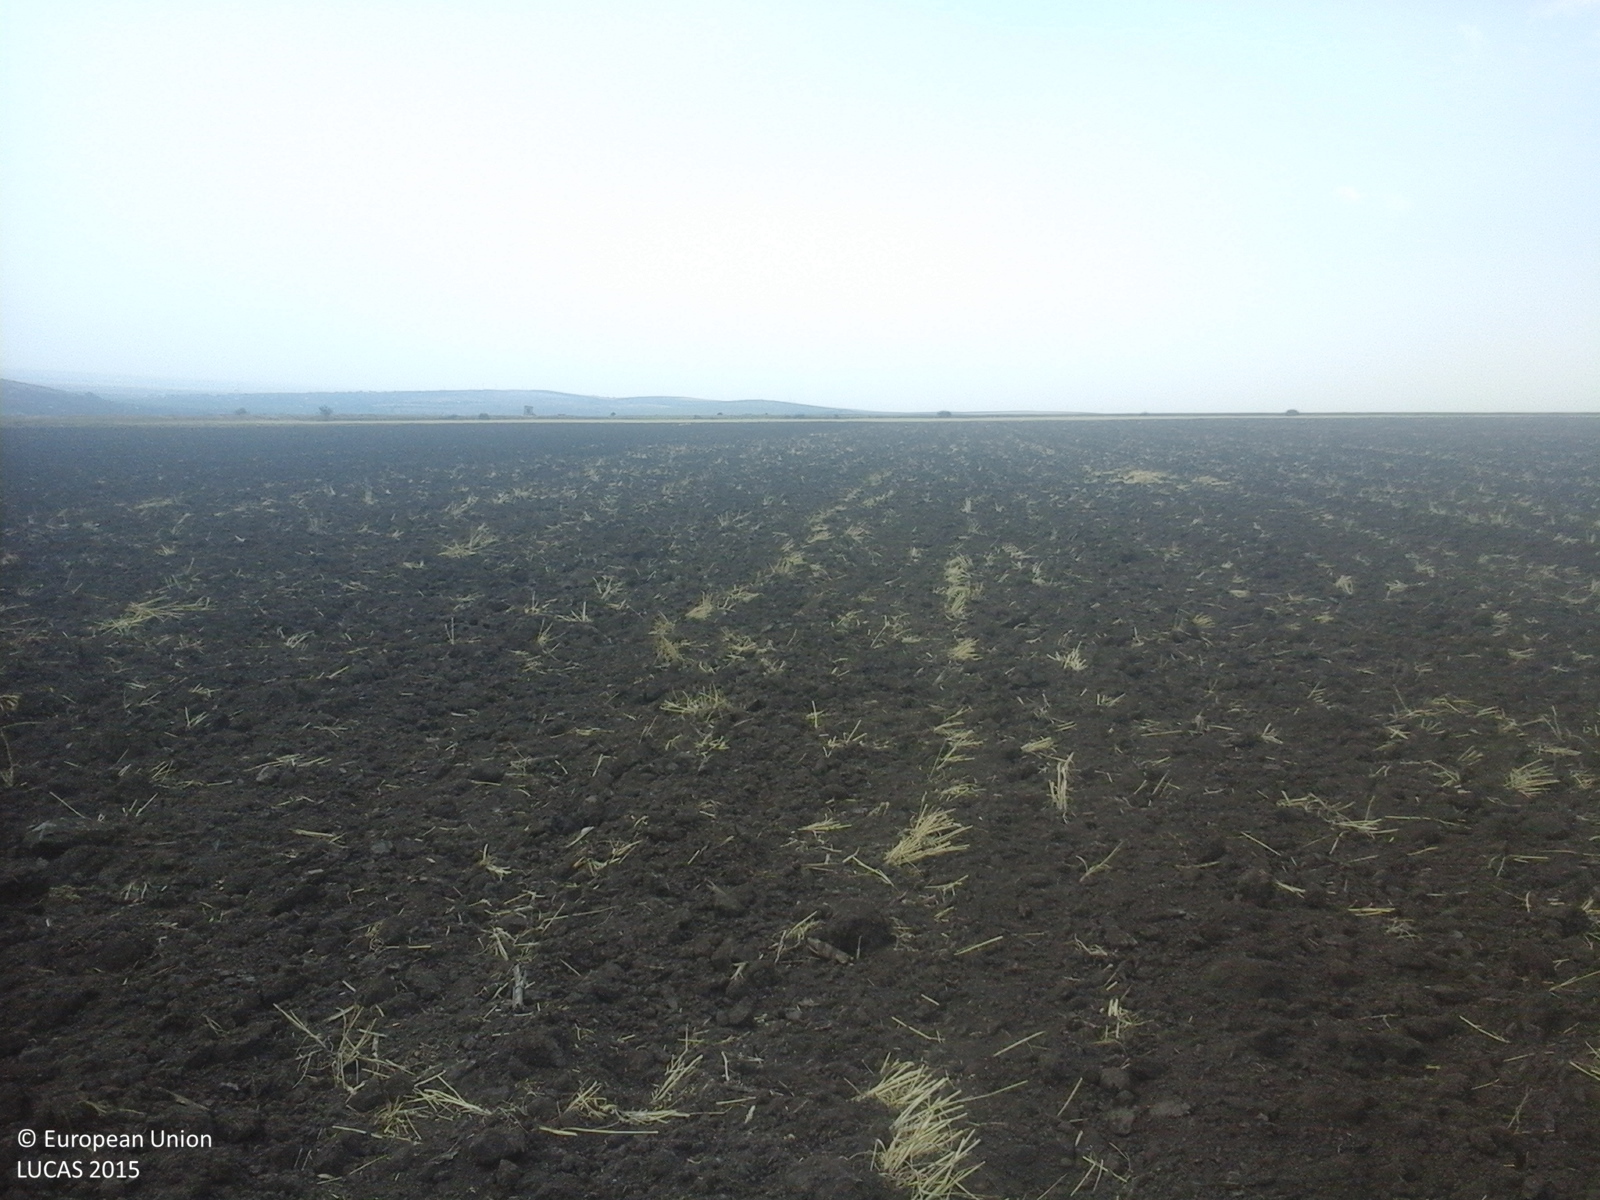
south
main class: Cropland
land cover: Durum wheat
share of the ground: < 10 %
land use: Agriculture (excluding fallow land and kitchen gardens)
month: July
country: RO
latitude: 45.8003
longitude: 28.0179
